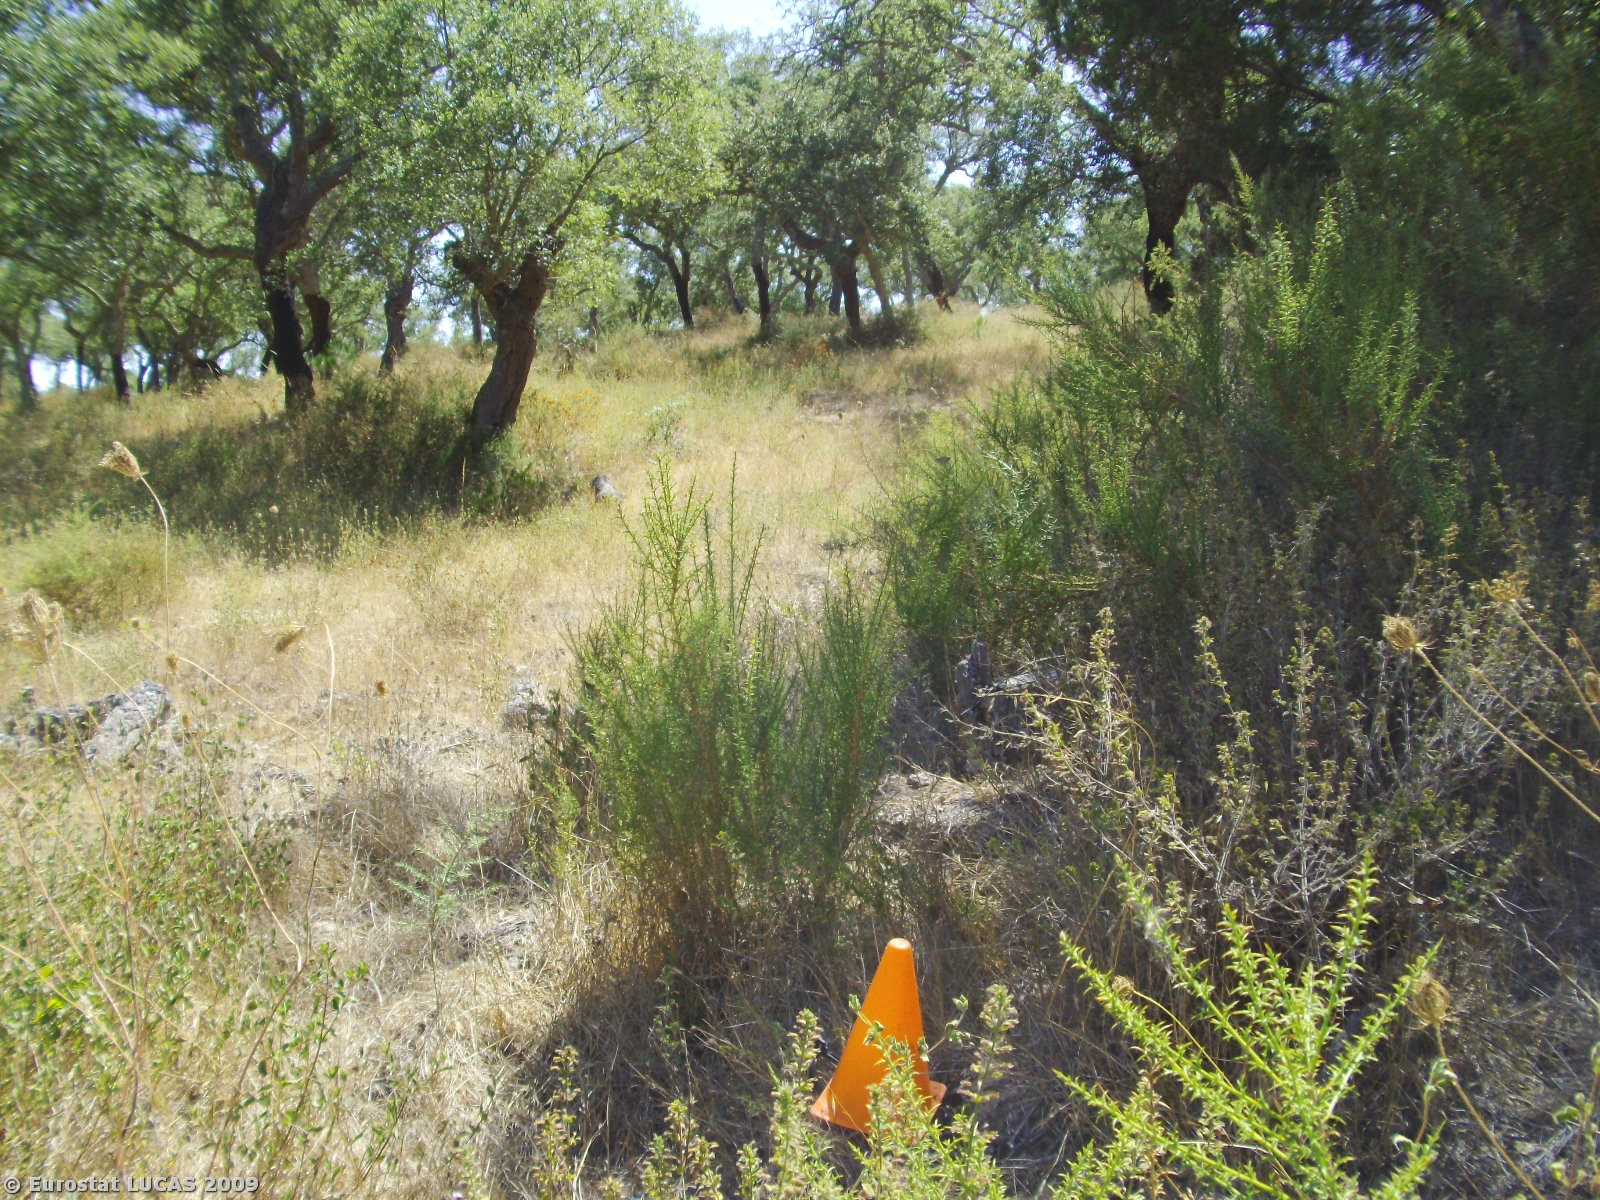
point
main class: Woodland
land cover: Broadleaved woodland
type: broadleaved evergreen forest
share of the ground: 50 - 75 %
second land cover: Spontaneously vegetated surfaces
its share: 50 - 75 %
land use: Forestry
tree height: > 5 m
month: July
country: PT
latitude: 38.3151
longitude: -8.4505
